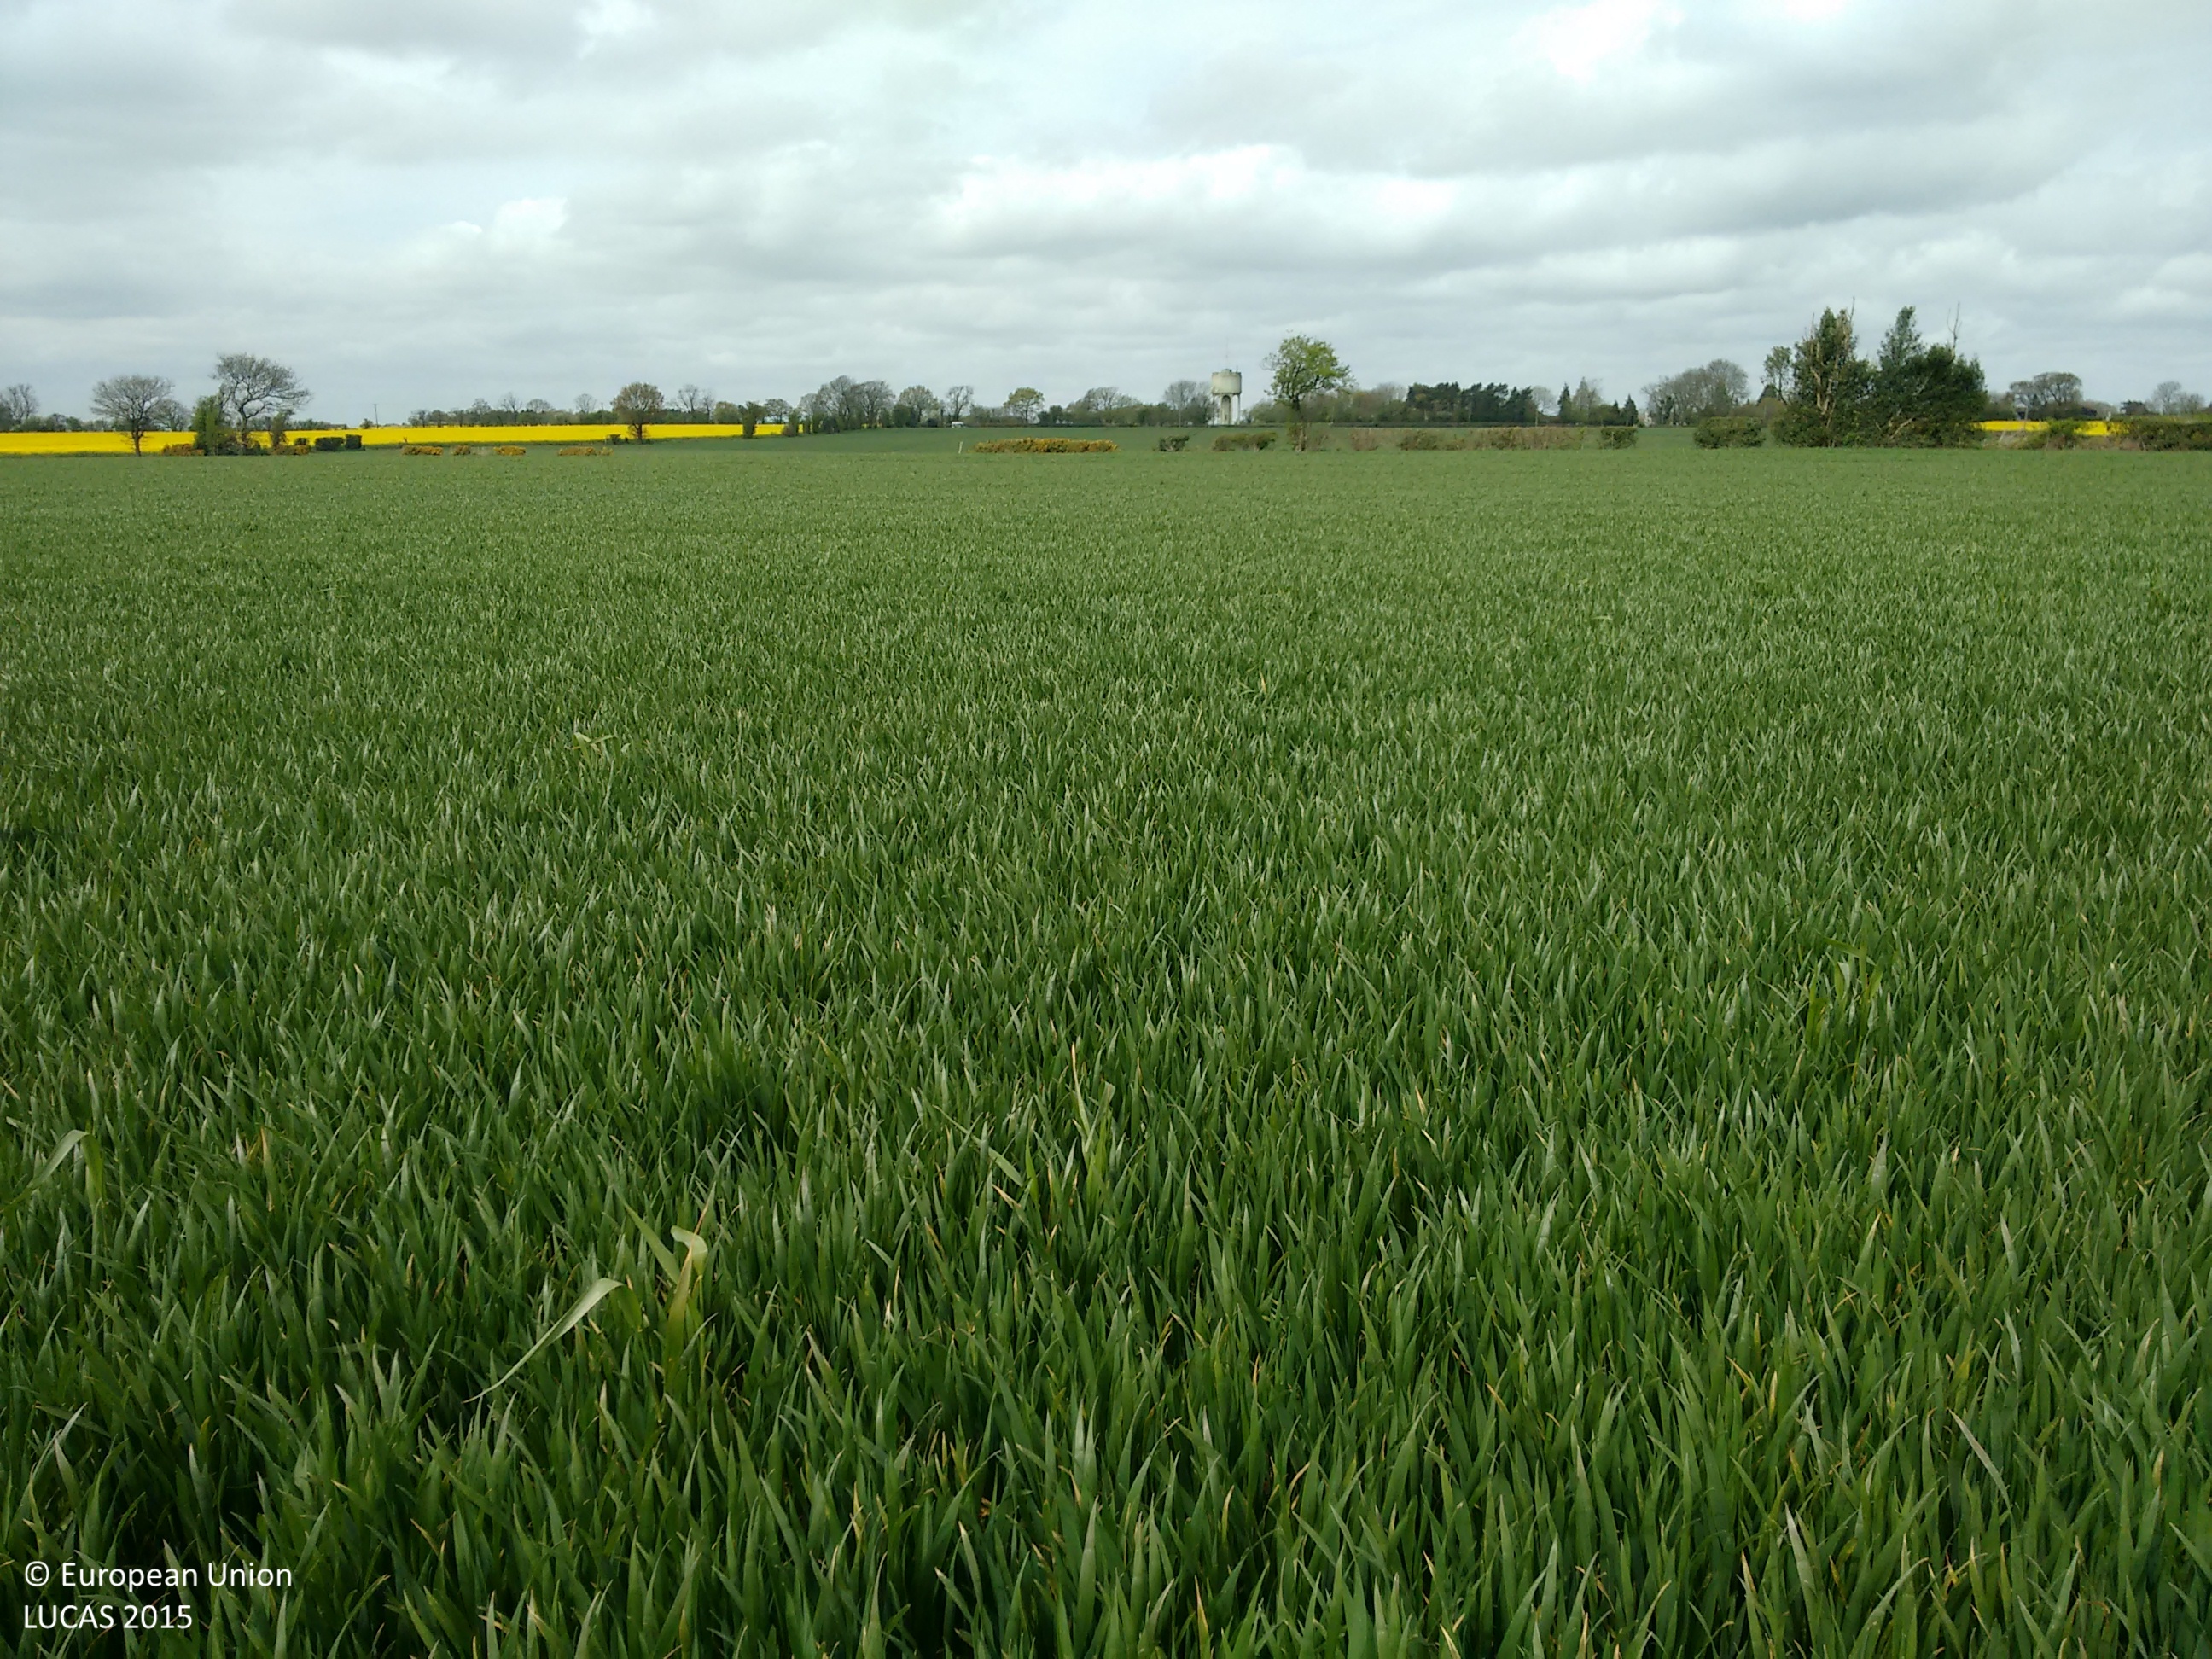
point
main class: Cropland
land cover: Common wheat
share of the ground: > 75 %
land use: Agriculture (excluding fallow land and kitchen gardens)
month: May
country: GB
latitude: 51.2386
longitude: 0.7646
